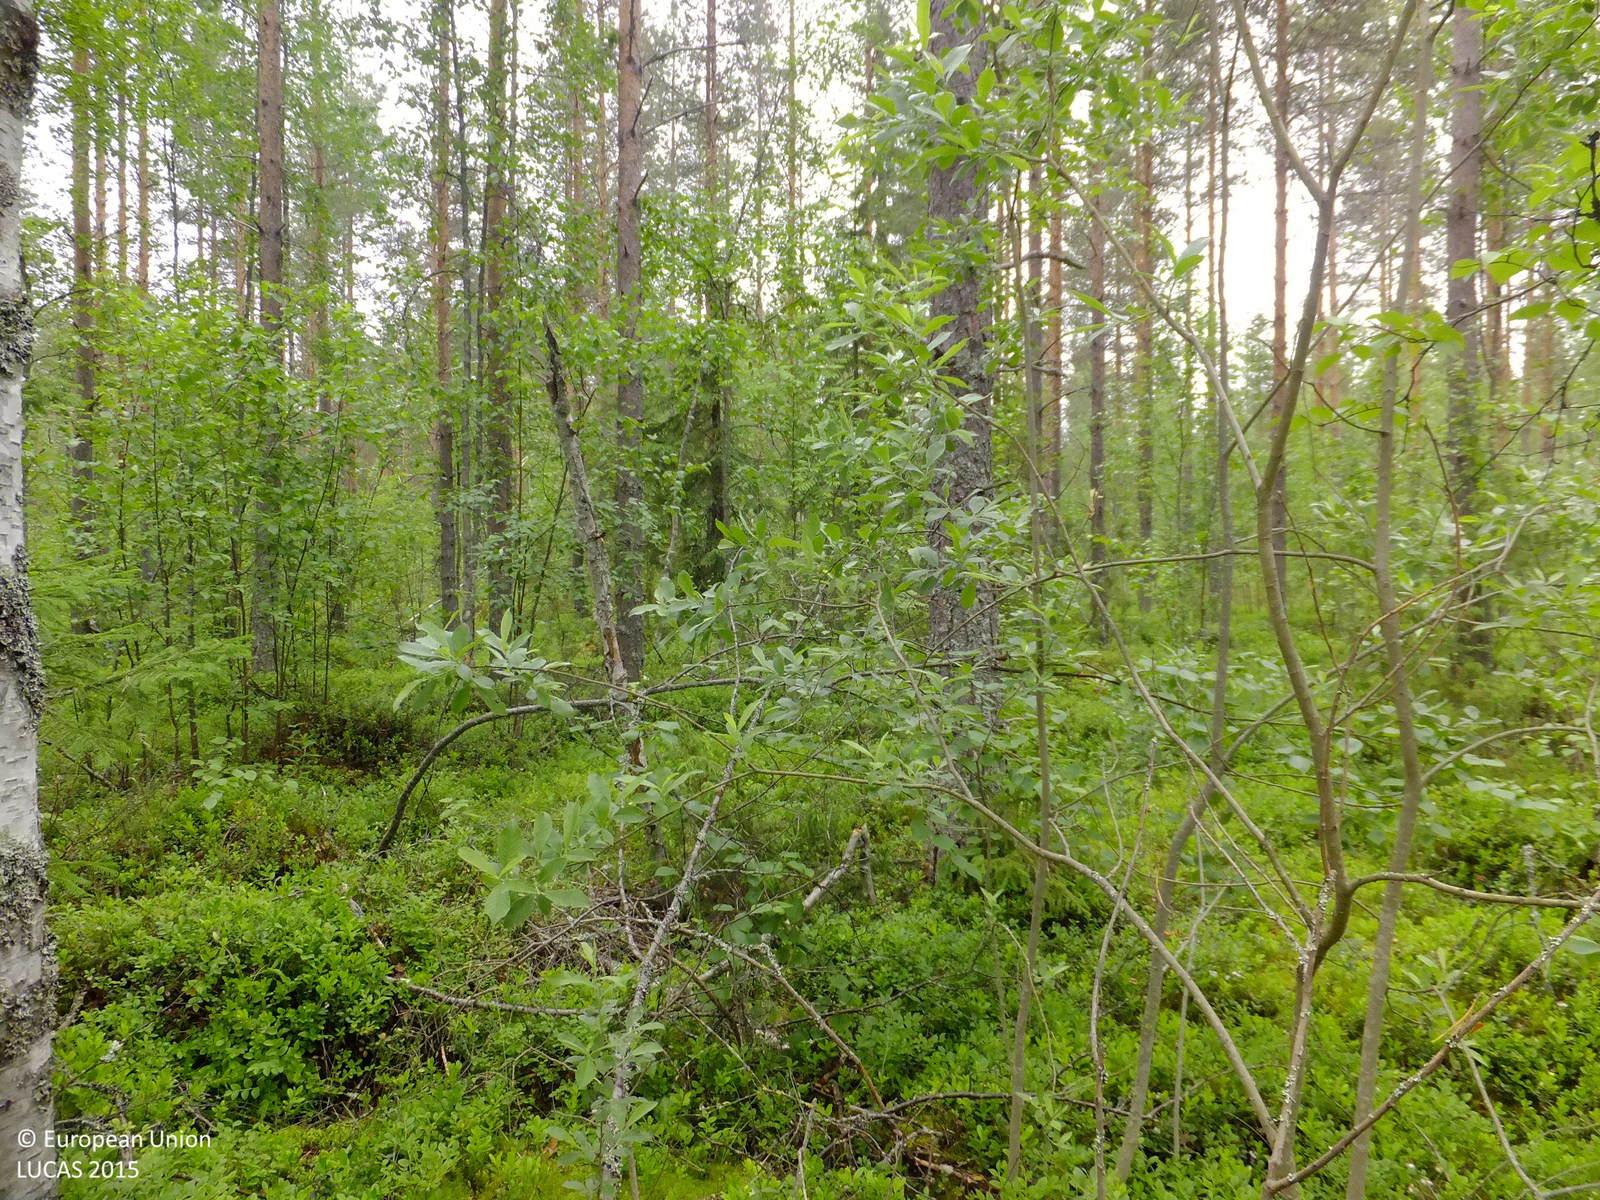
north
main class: Woodland
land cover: Pine dominated mixed woodland
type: boreal forest
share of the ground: 50 - 75 %
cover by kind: coniferous forest trees 35 %, shrubs 30 %, broadleaved forest trees 20 %, lichens and mosses 10 %, herbaceous plants 5 %
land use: Forestry
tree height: > 5 m
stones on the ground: 10 - 25 %
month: July
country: FI
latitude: 63.0662
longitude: 24.6718
